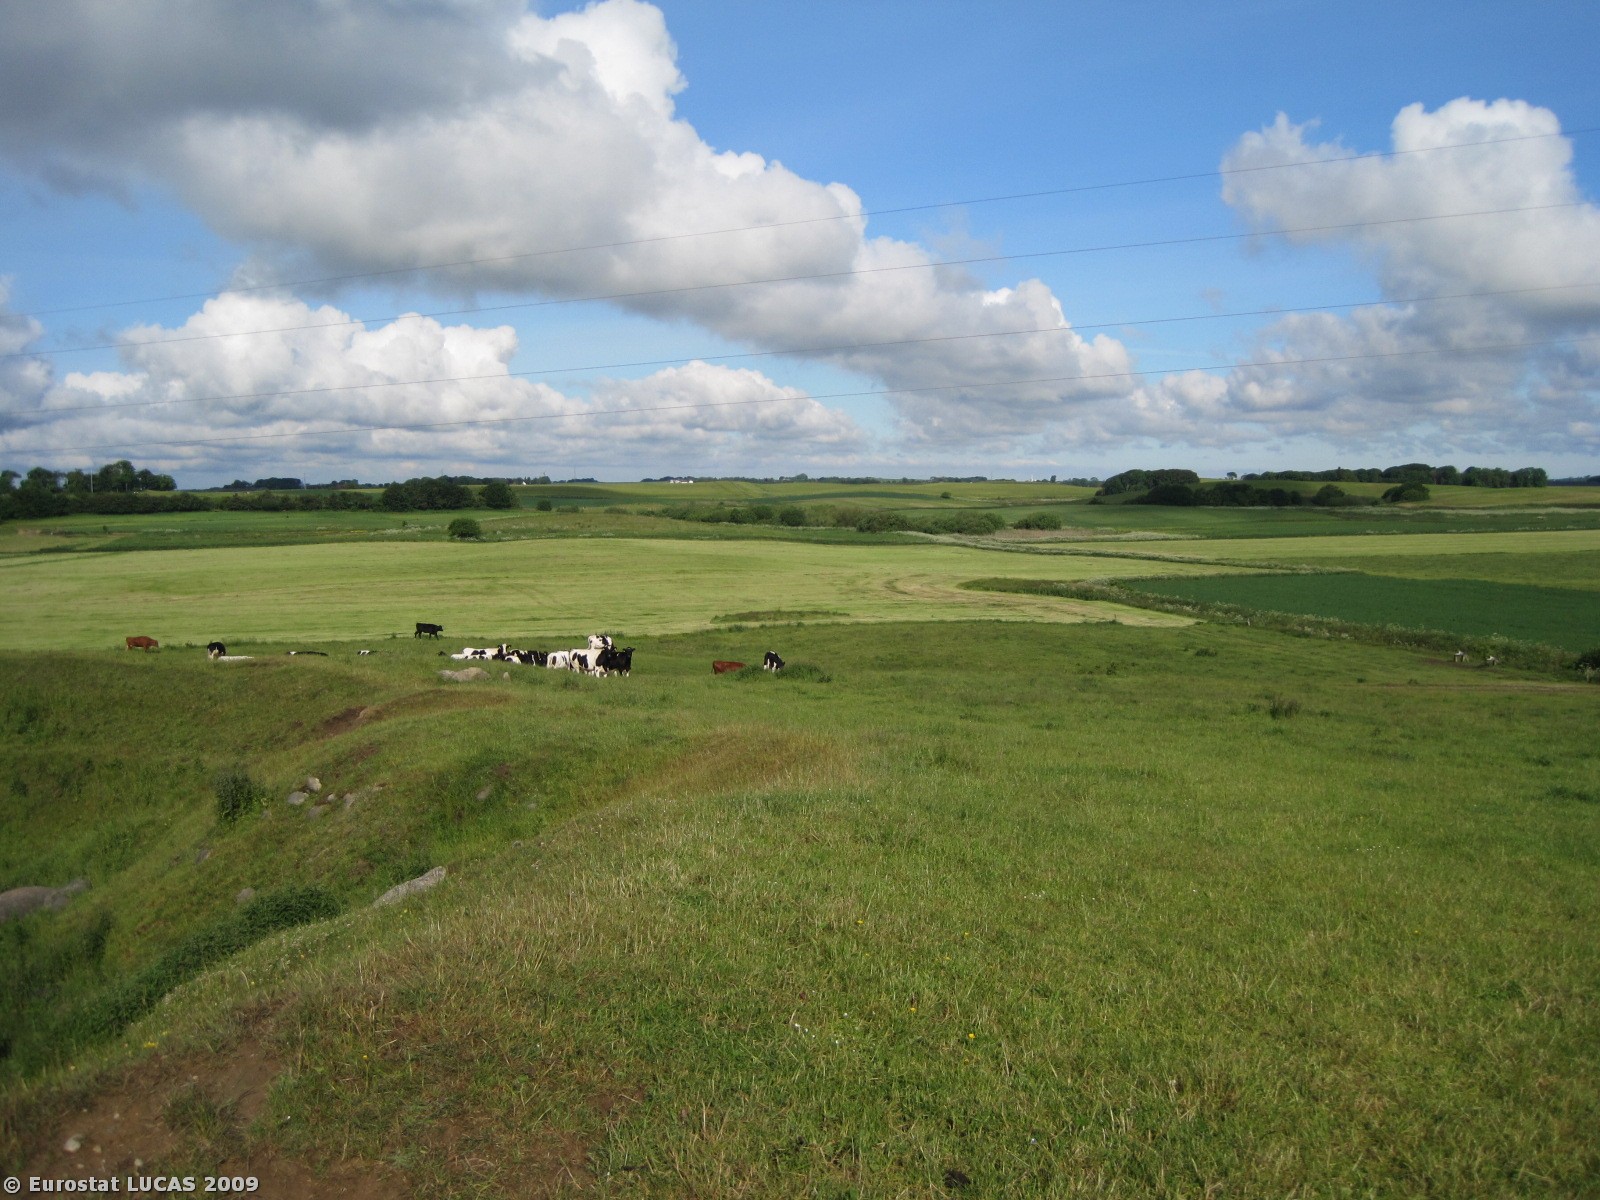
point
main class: Grassland
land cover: Grassland without tree/shrub cover
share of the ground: > 75 %
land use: Agriculture (excluding fallow land and kitchen gardens)
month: June
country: DK
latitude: 57.3023
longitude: 10.1491
